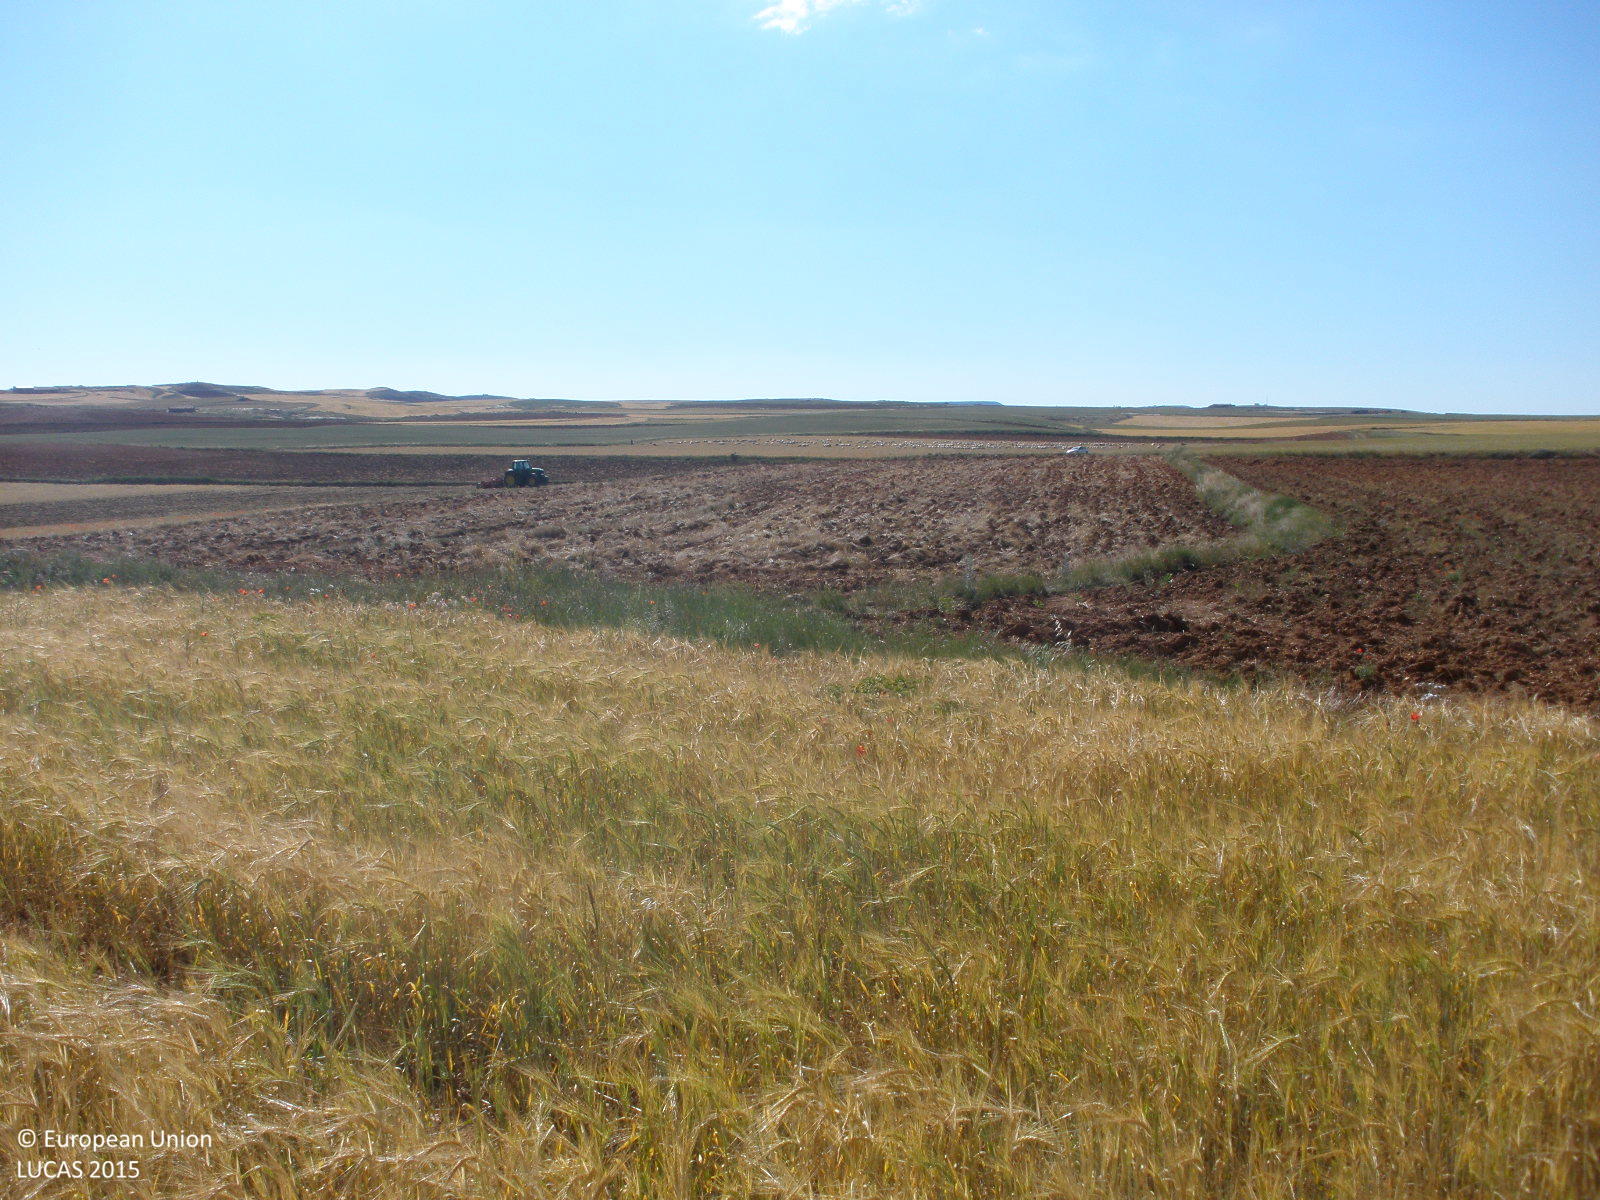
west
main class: Cropland
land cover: Barley
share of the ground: > 75 %
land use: Agriculture (excluding fallow land and kitchen gardens)
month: June
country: ES
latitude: 40.6217
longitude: -1.0898
